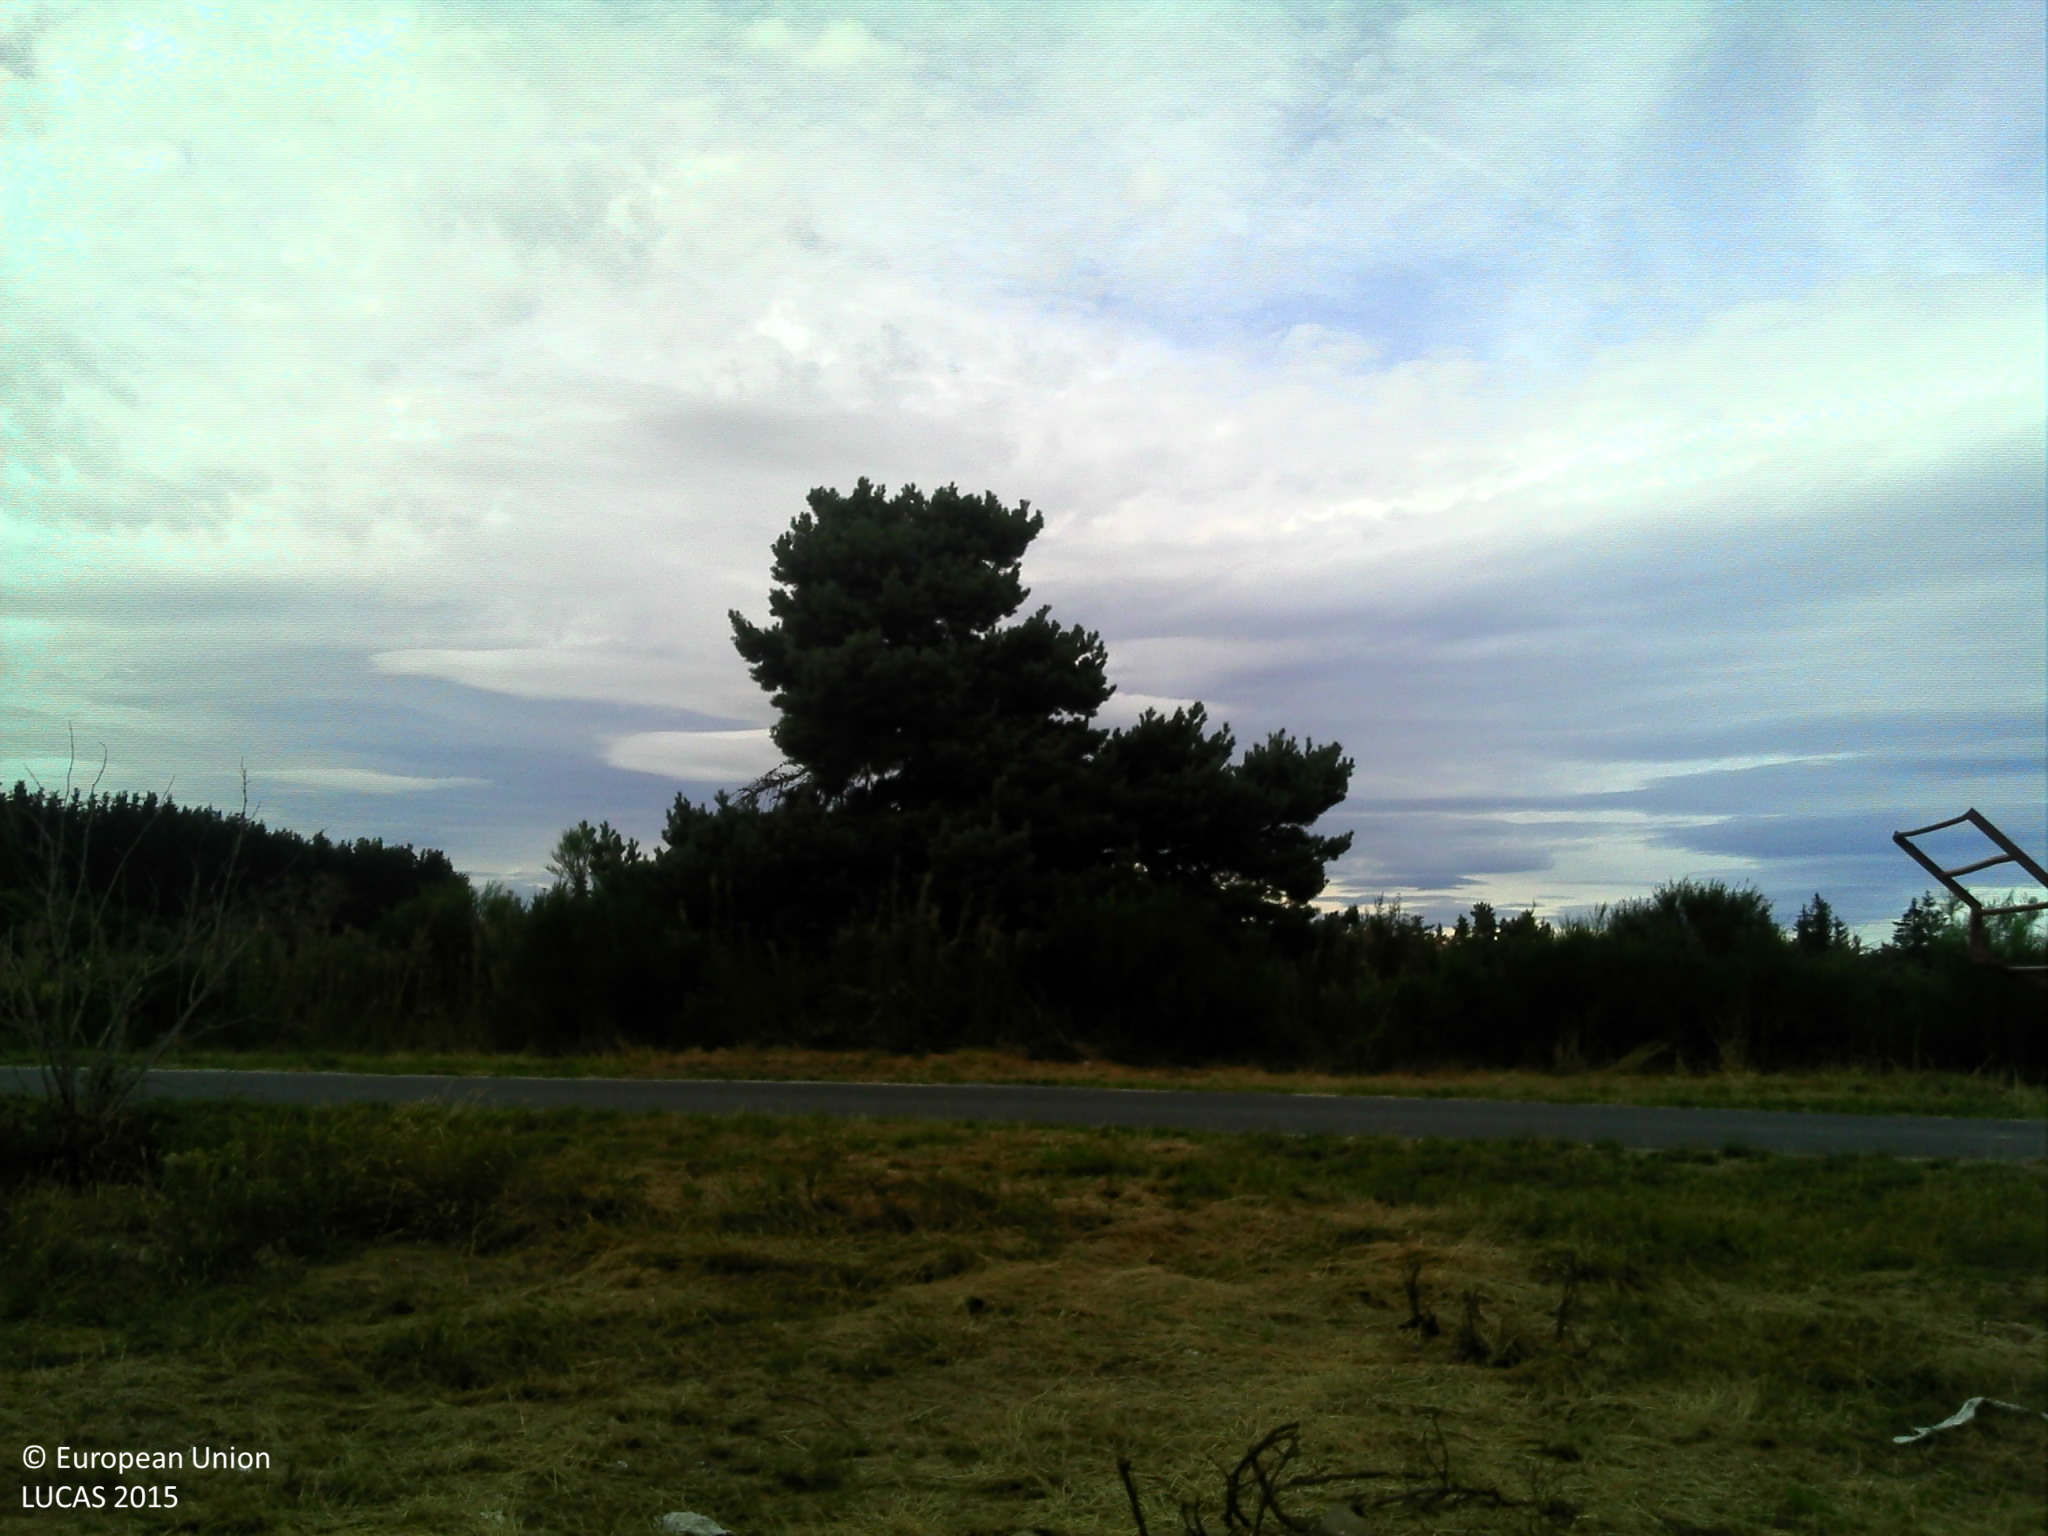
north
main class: Grassland
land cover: Grassland without tree/shrub cover
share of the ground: > 75 %
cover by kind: herbaceous plants 95 %, shrubs 5 %
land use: Agriculture (excluding fallow land and kitchen gardens)
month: July
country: FR
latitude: 44.8353
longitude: 3.2358
